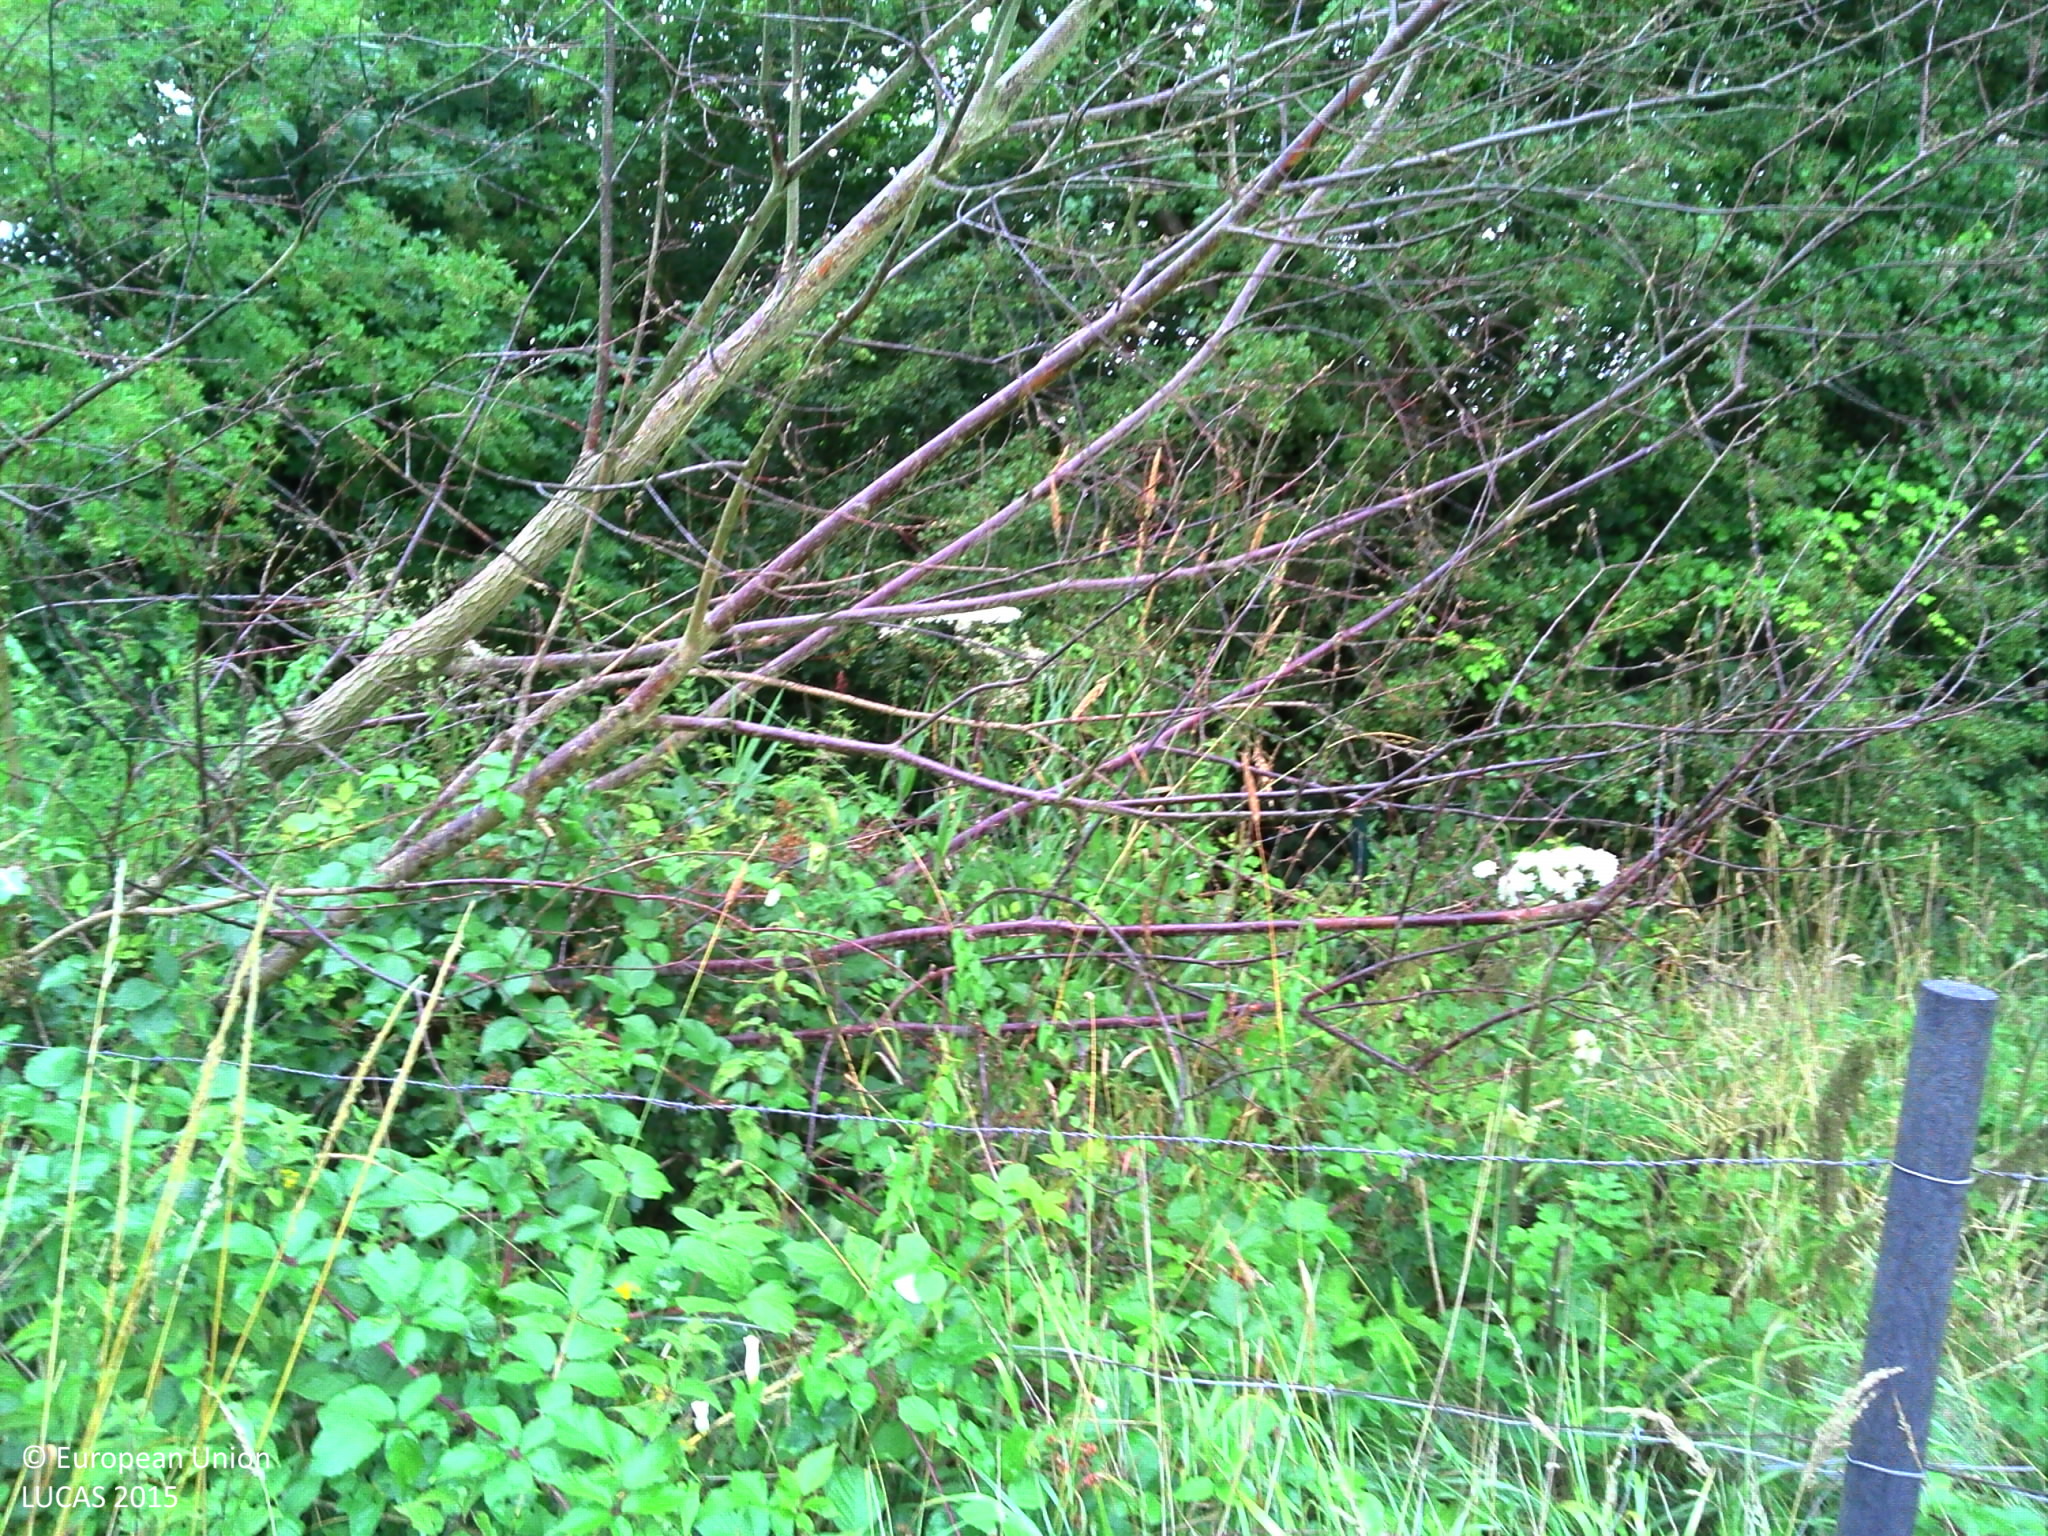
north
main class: Grassland
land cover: Grassland without tree/shrub cover
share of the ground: > 75 %
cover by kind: herbaceous plants 100 %
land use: Agriculture (excluding fallow land and kitchen gardens)
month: July
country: BE
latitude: 50.5818
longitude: 3.9353
